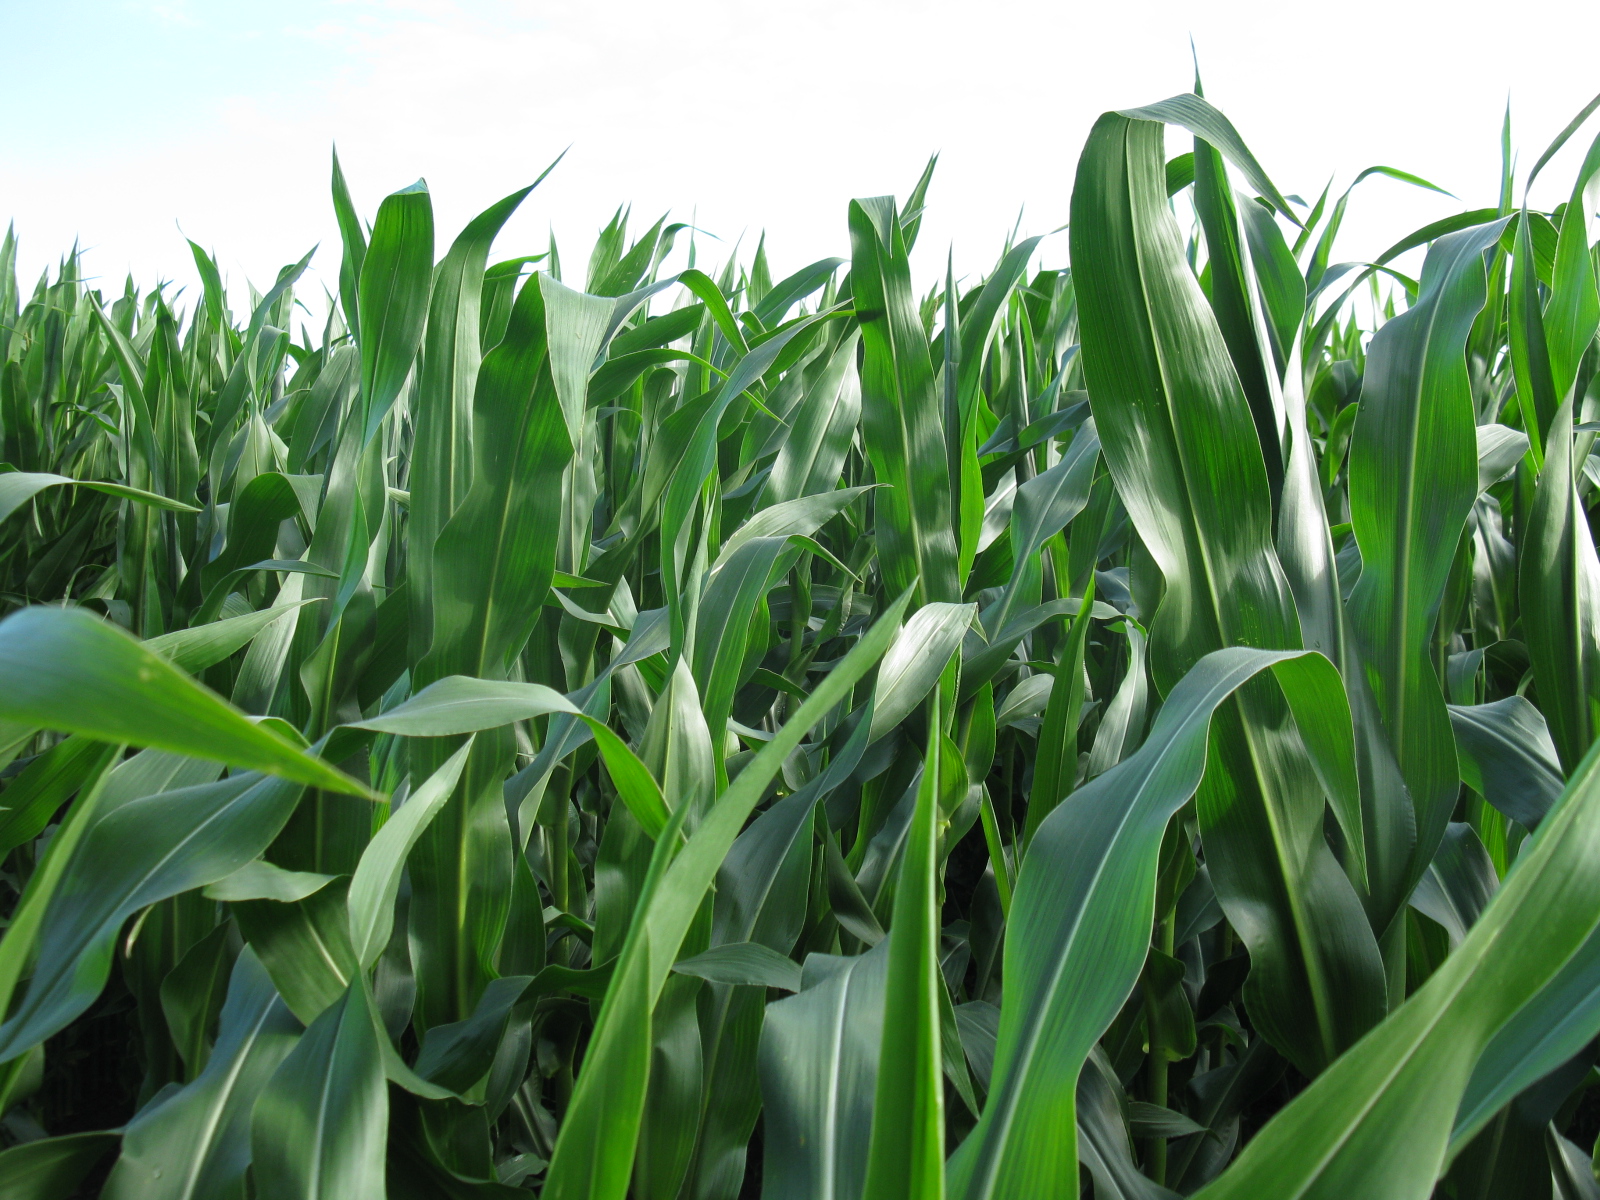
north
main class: Cropland
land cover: Maize
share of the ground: > 75 %
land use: Agriculture (excluding fallow land and kitchen gardens)
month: July
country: DE
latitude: 53.0873
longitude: 8.5224
